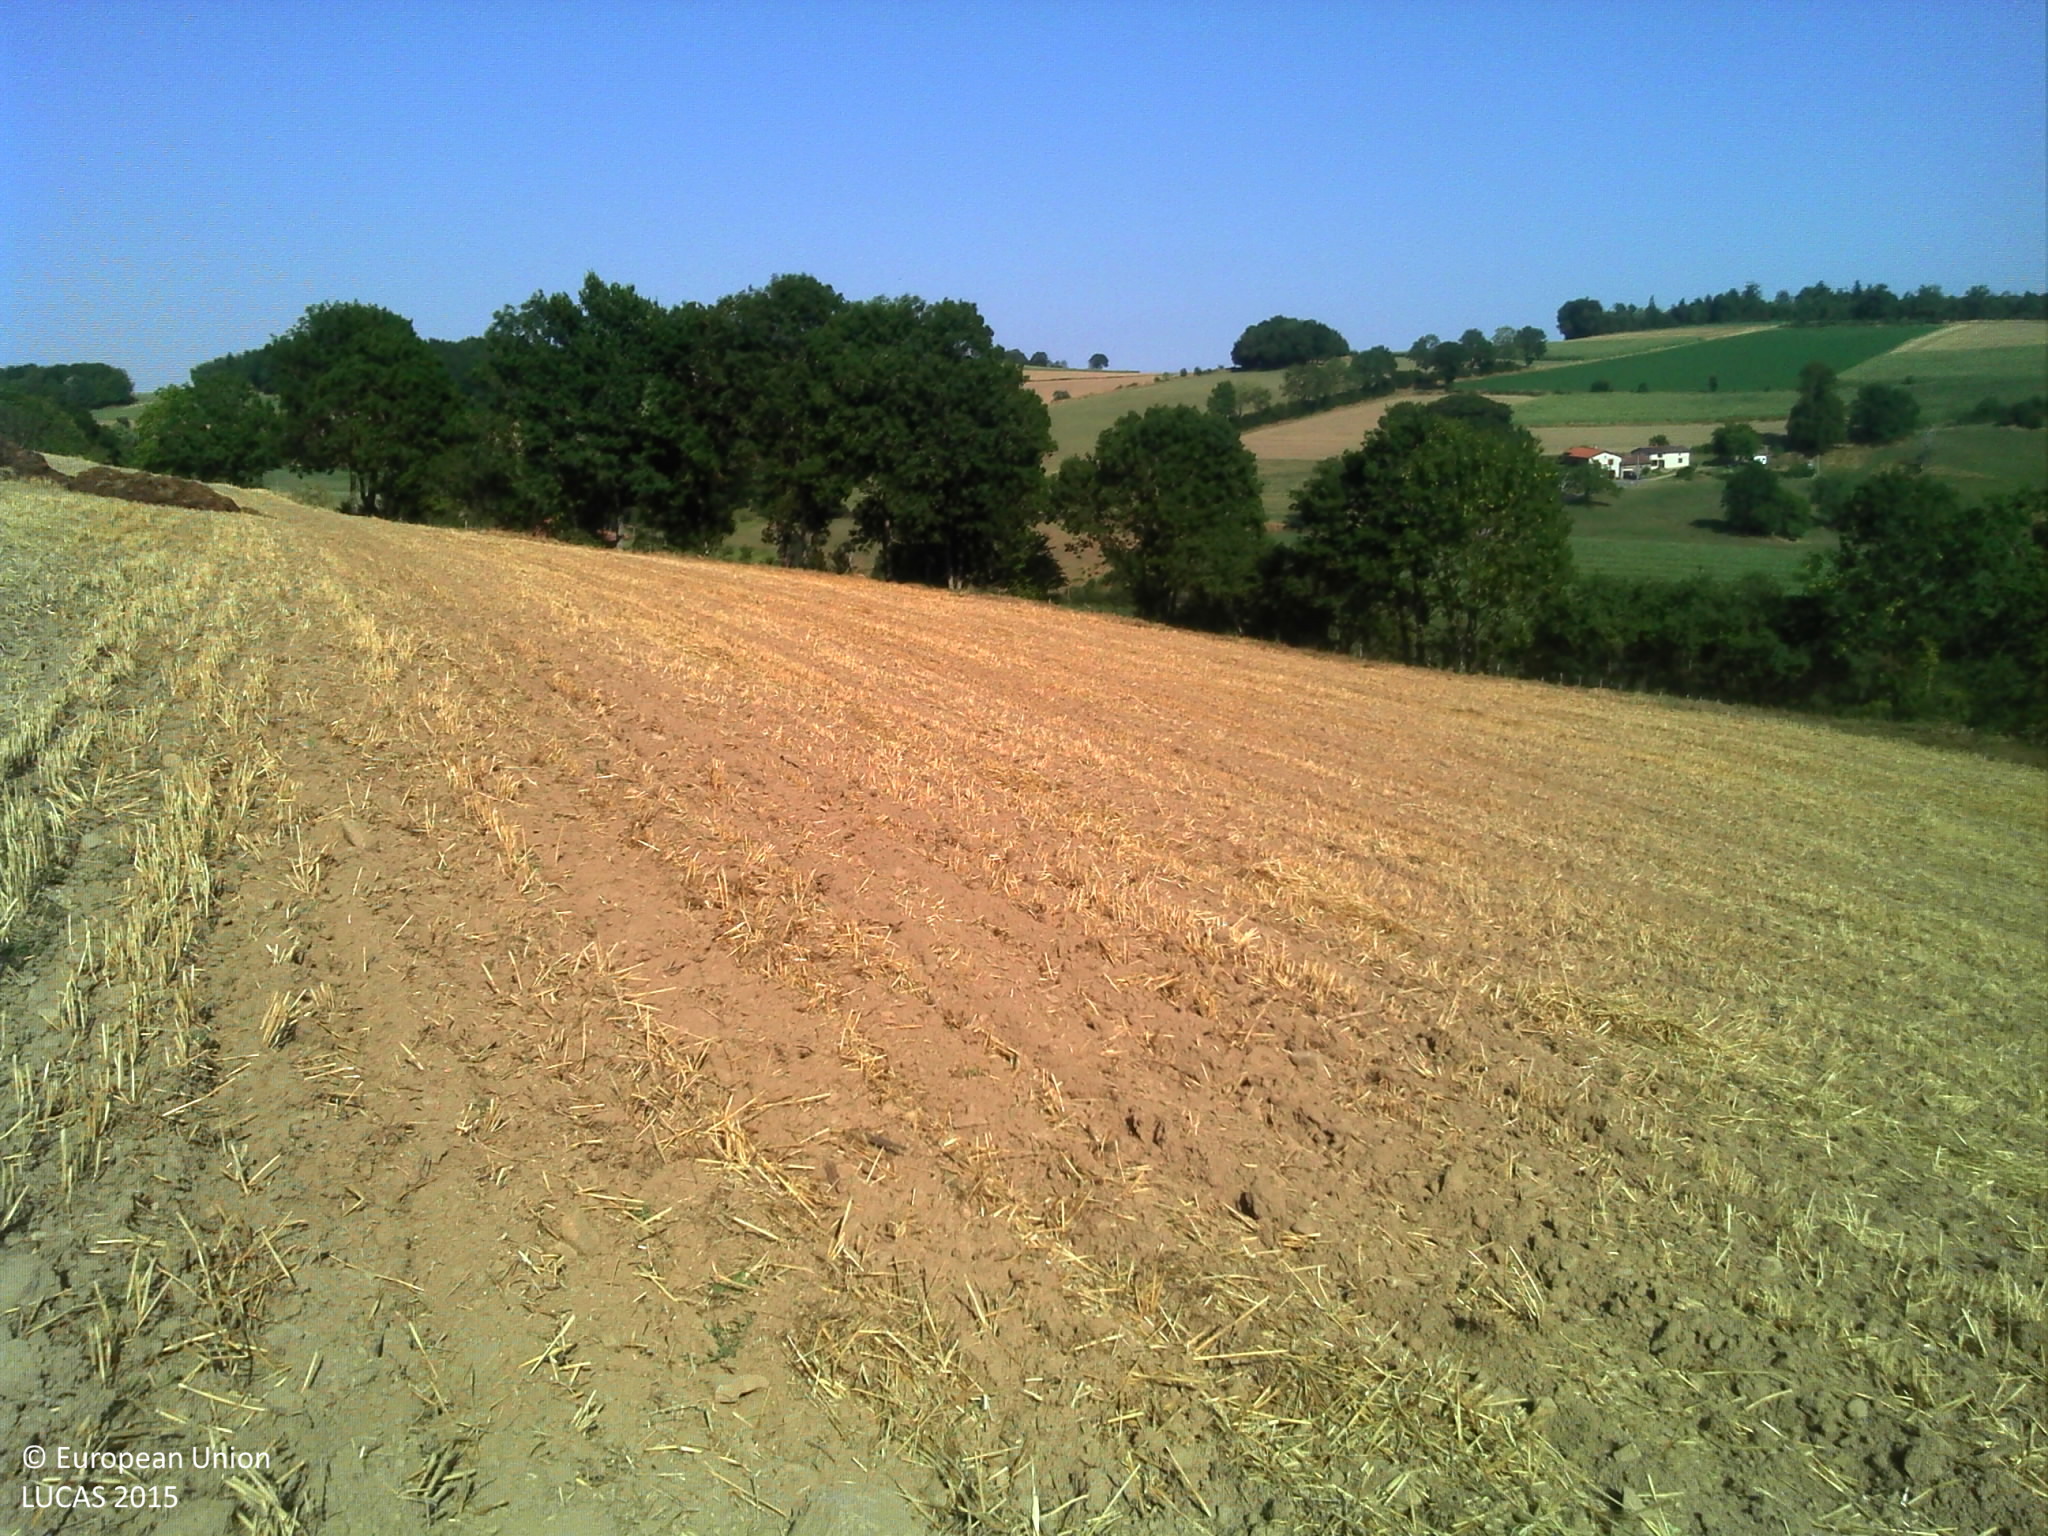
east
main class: Cropland
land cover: Durum wheat
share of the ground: 10 - 25 %
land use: Agriculture (excluding fallow land and kitchen gardens)
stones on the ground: 10 - 25 %
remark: Harvested field
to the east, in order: Durum wheat; Grass margins; Dry stone walls; Tracks; Abandoned hedges; Fences; Grassland without tree/shrub cover; Fences; Grassland without tree/shrub cover; Fences; Grassland without tree/shrub cover
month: August
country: FR
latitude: 45.6180
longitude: 4.5788
